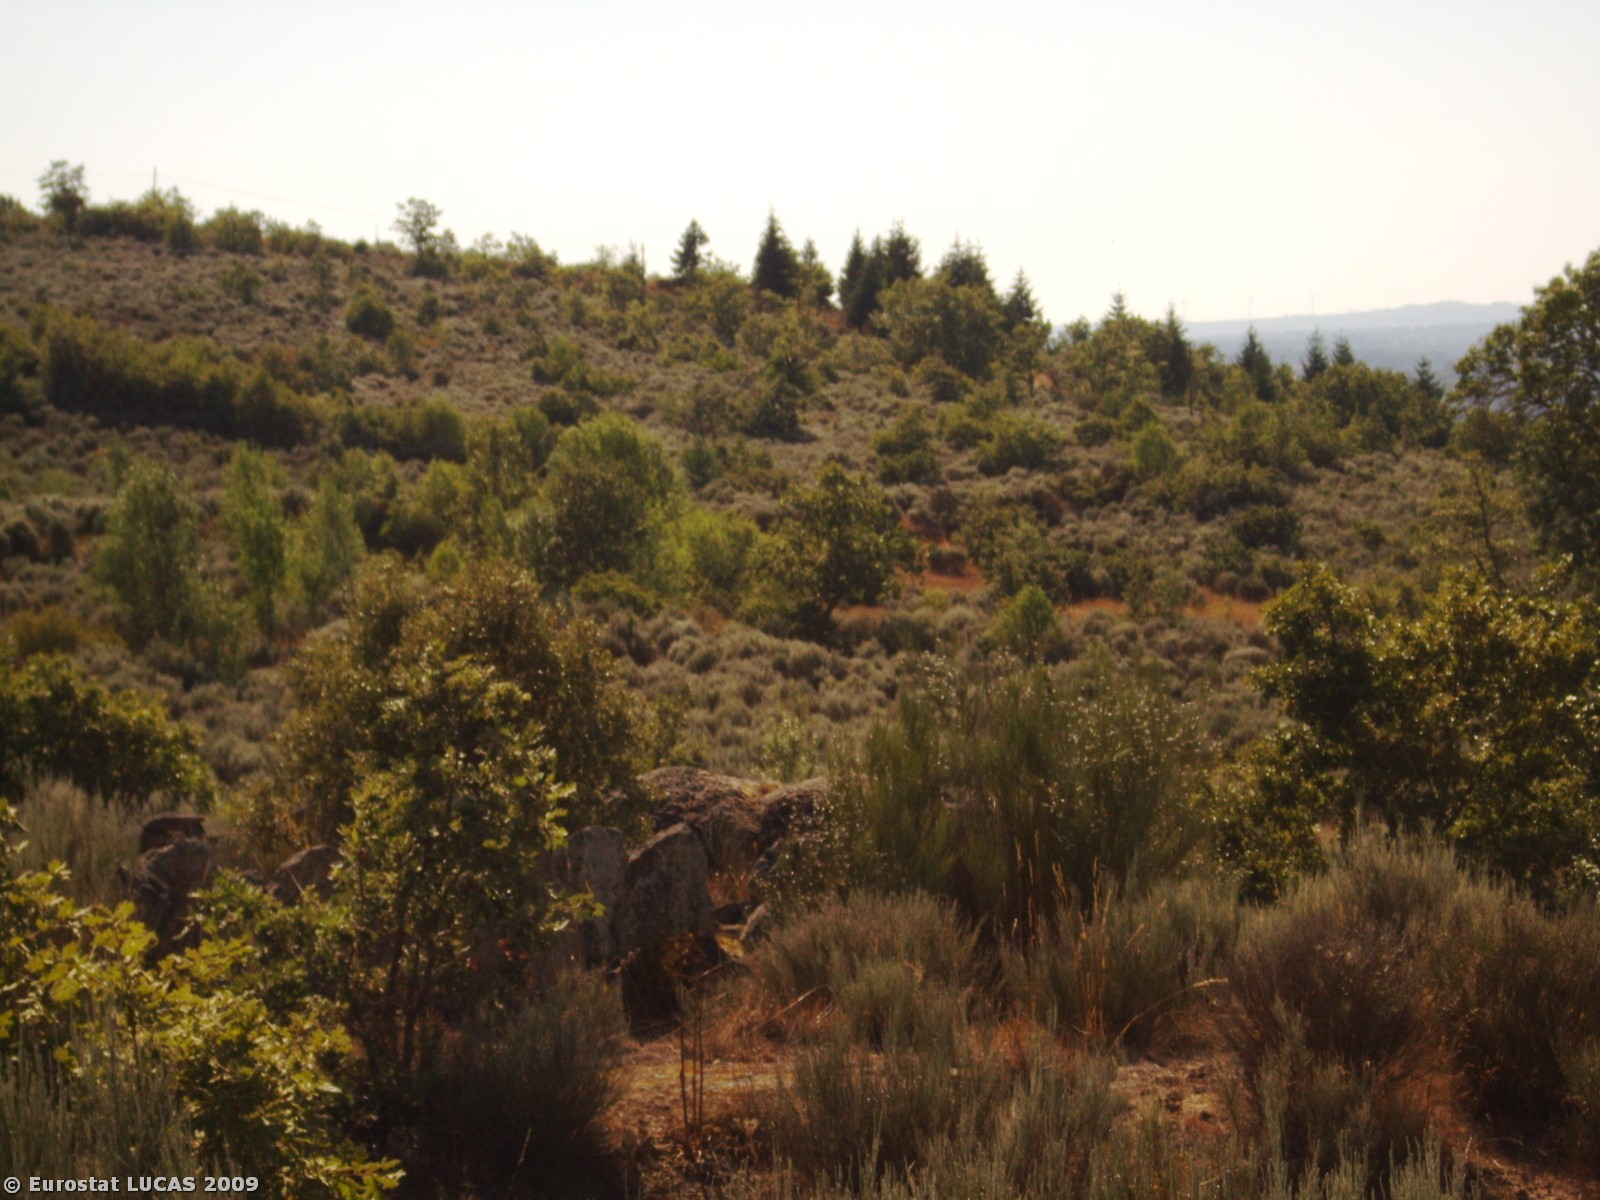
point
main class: Shrubland
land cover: Shrubland with sparse tree cover
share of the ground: > 75 %
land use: Forestry
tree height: > 5 m
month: July
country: PT
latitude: 40.5299
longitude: -7.0647
